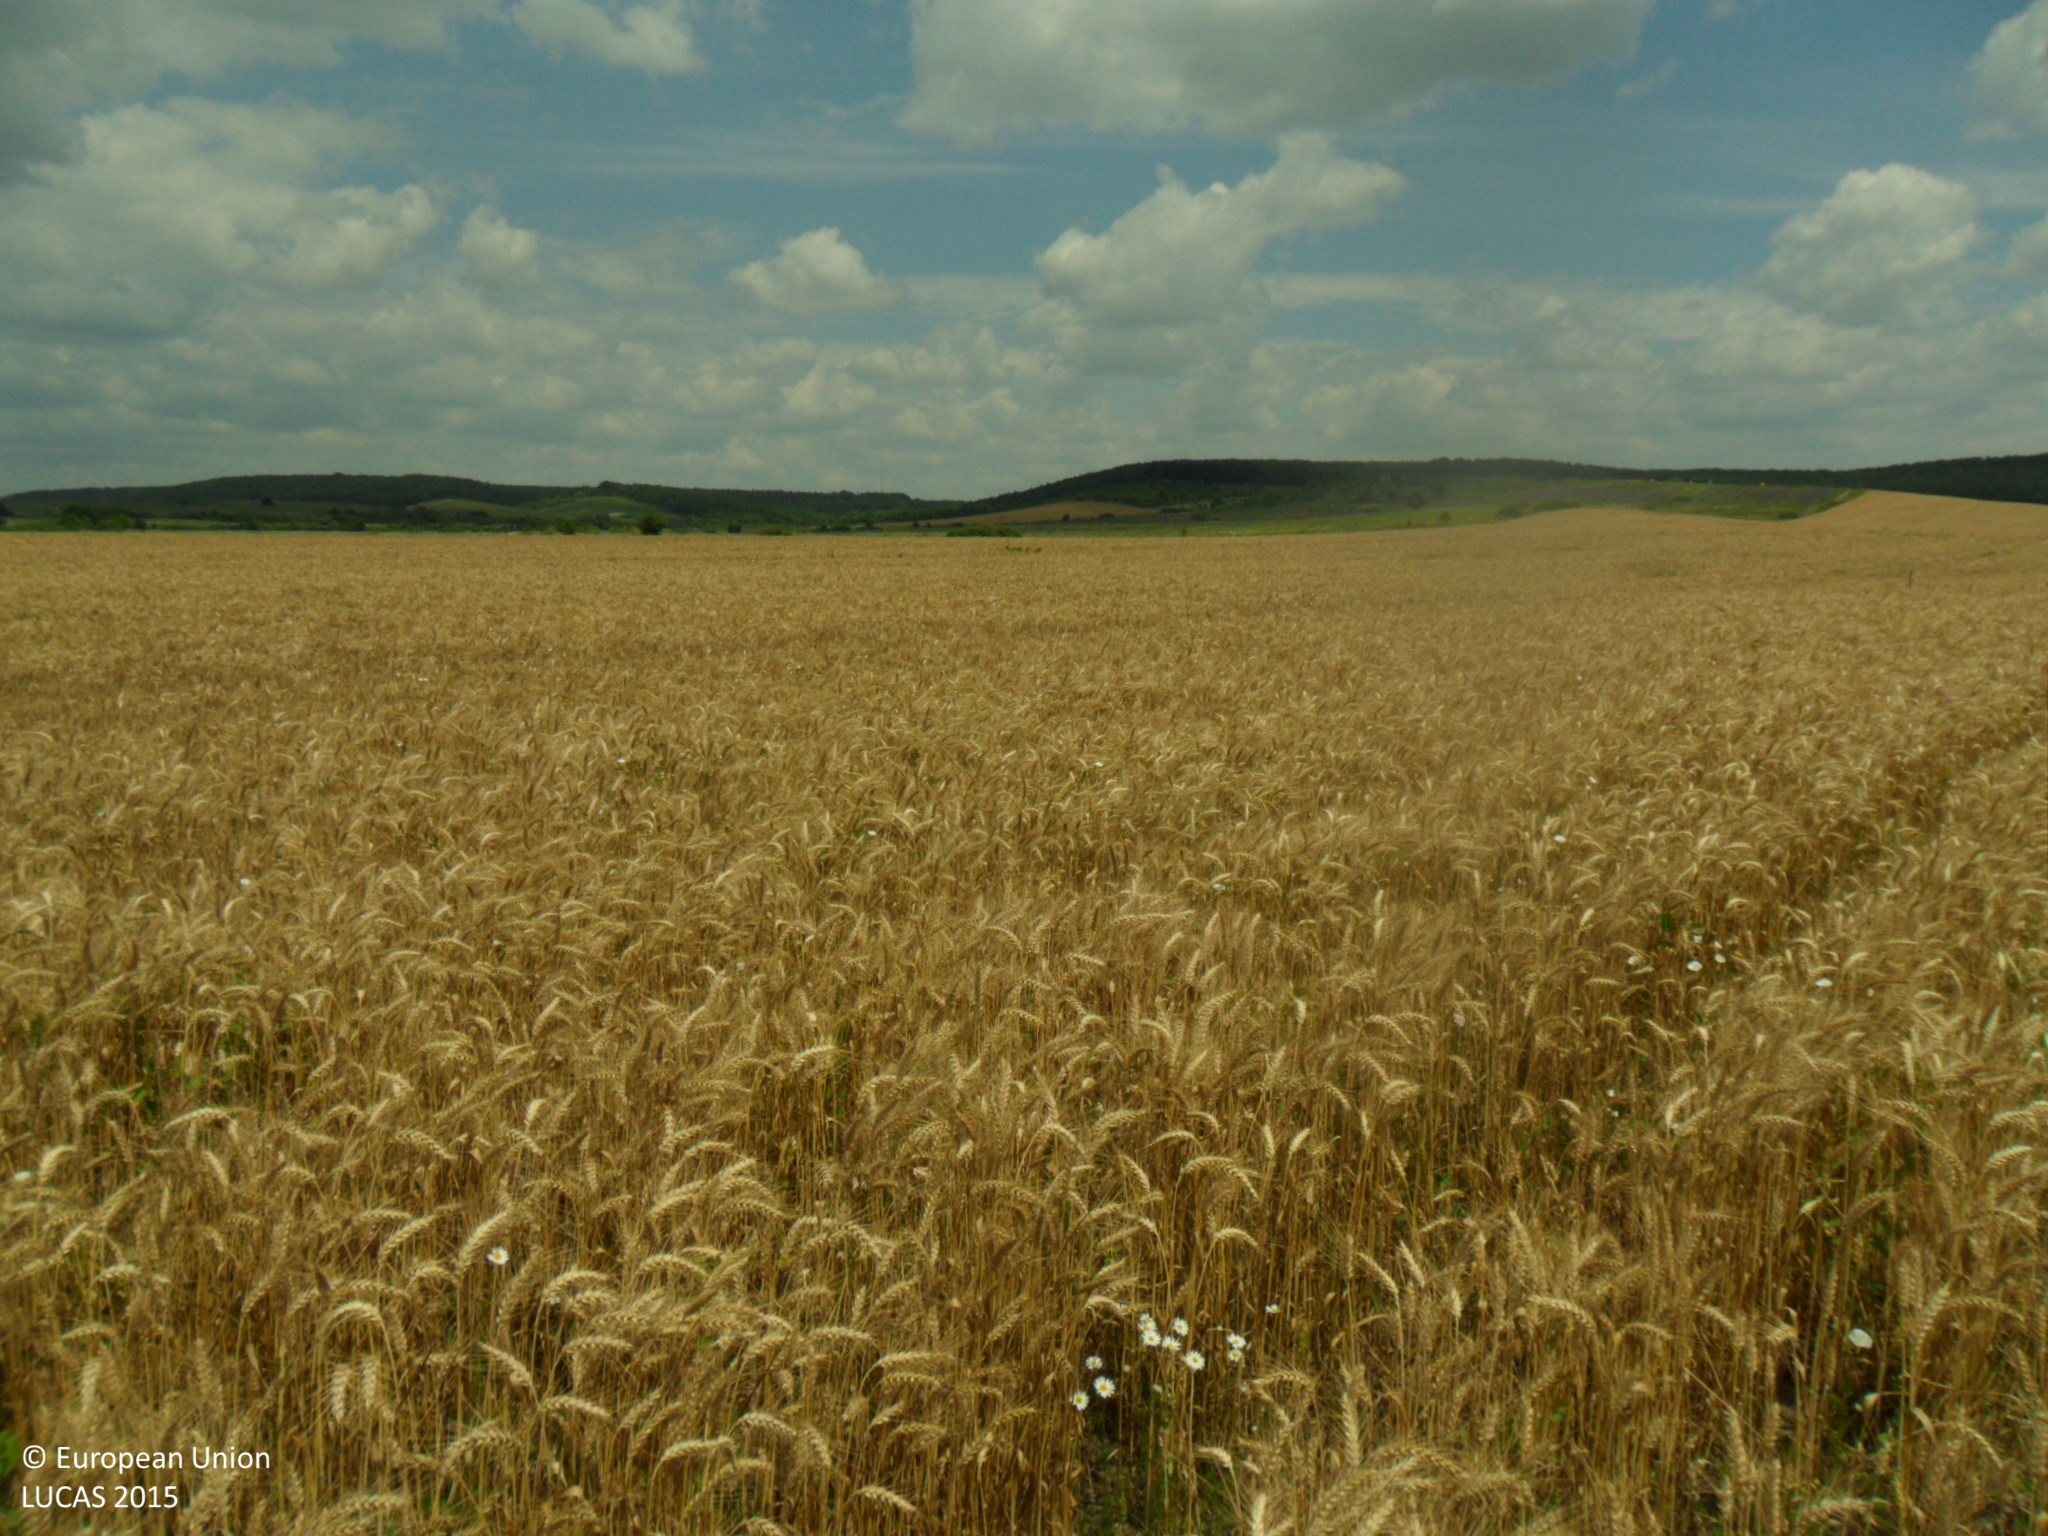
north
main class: Cropland
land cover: Common wheat
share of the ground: > 75 %
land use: Agriculture (excluding fallow land and kitchen gardens)
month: June
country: BG
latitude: 43.1254
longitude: 26.9638
